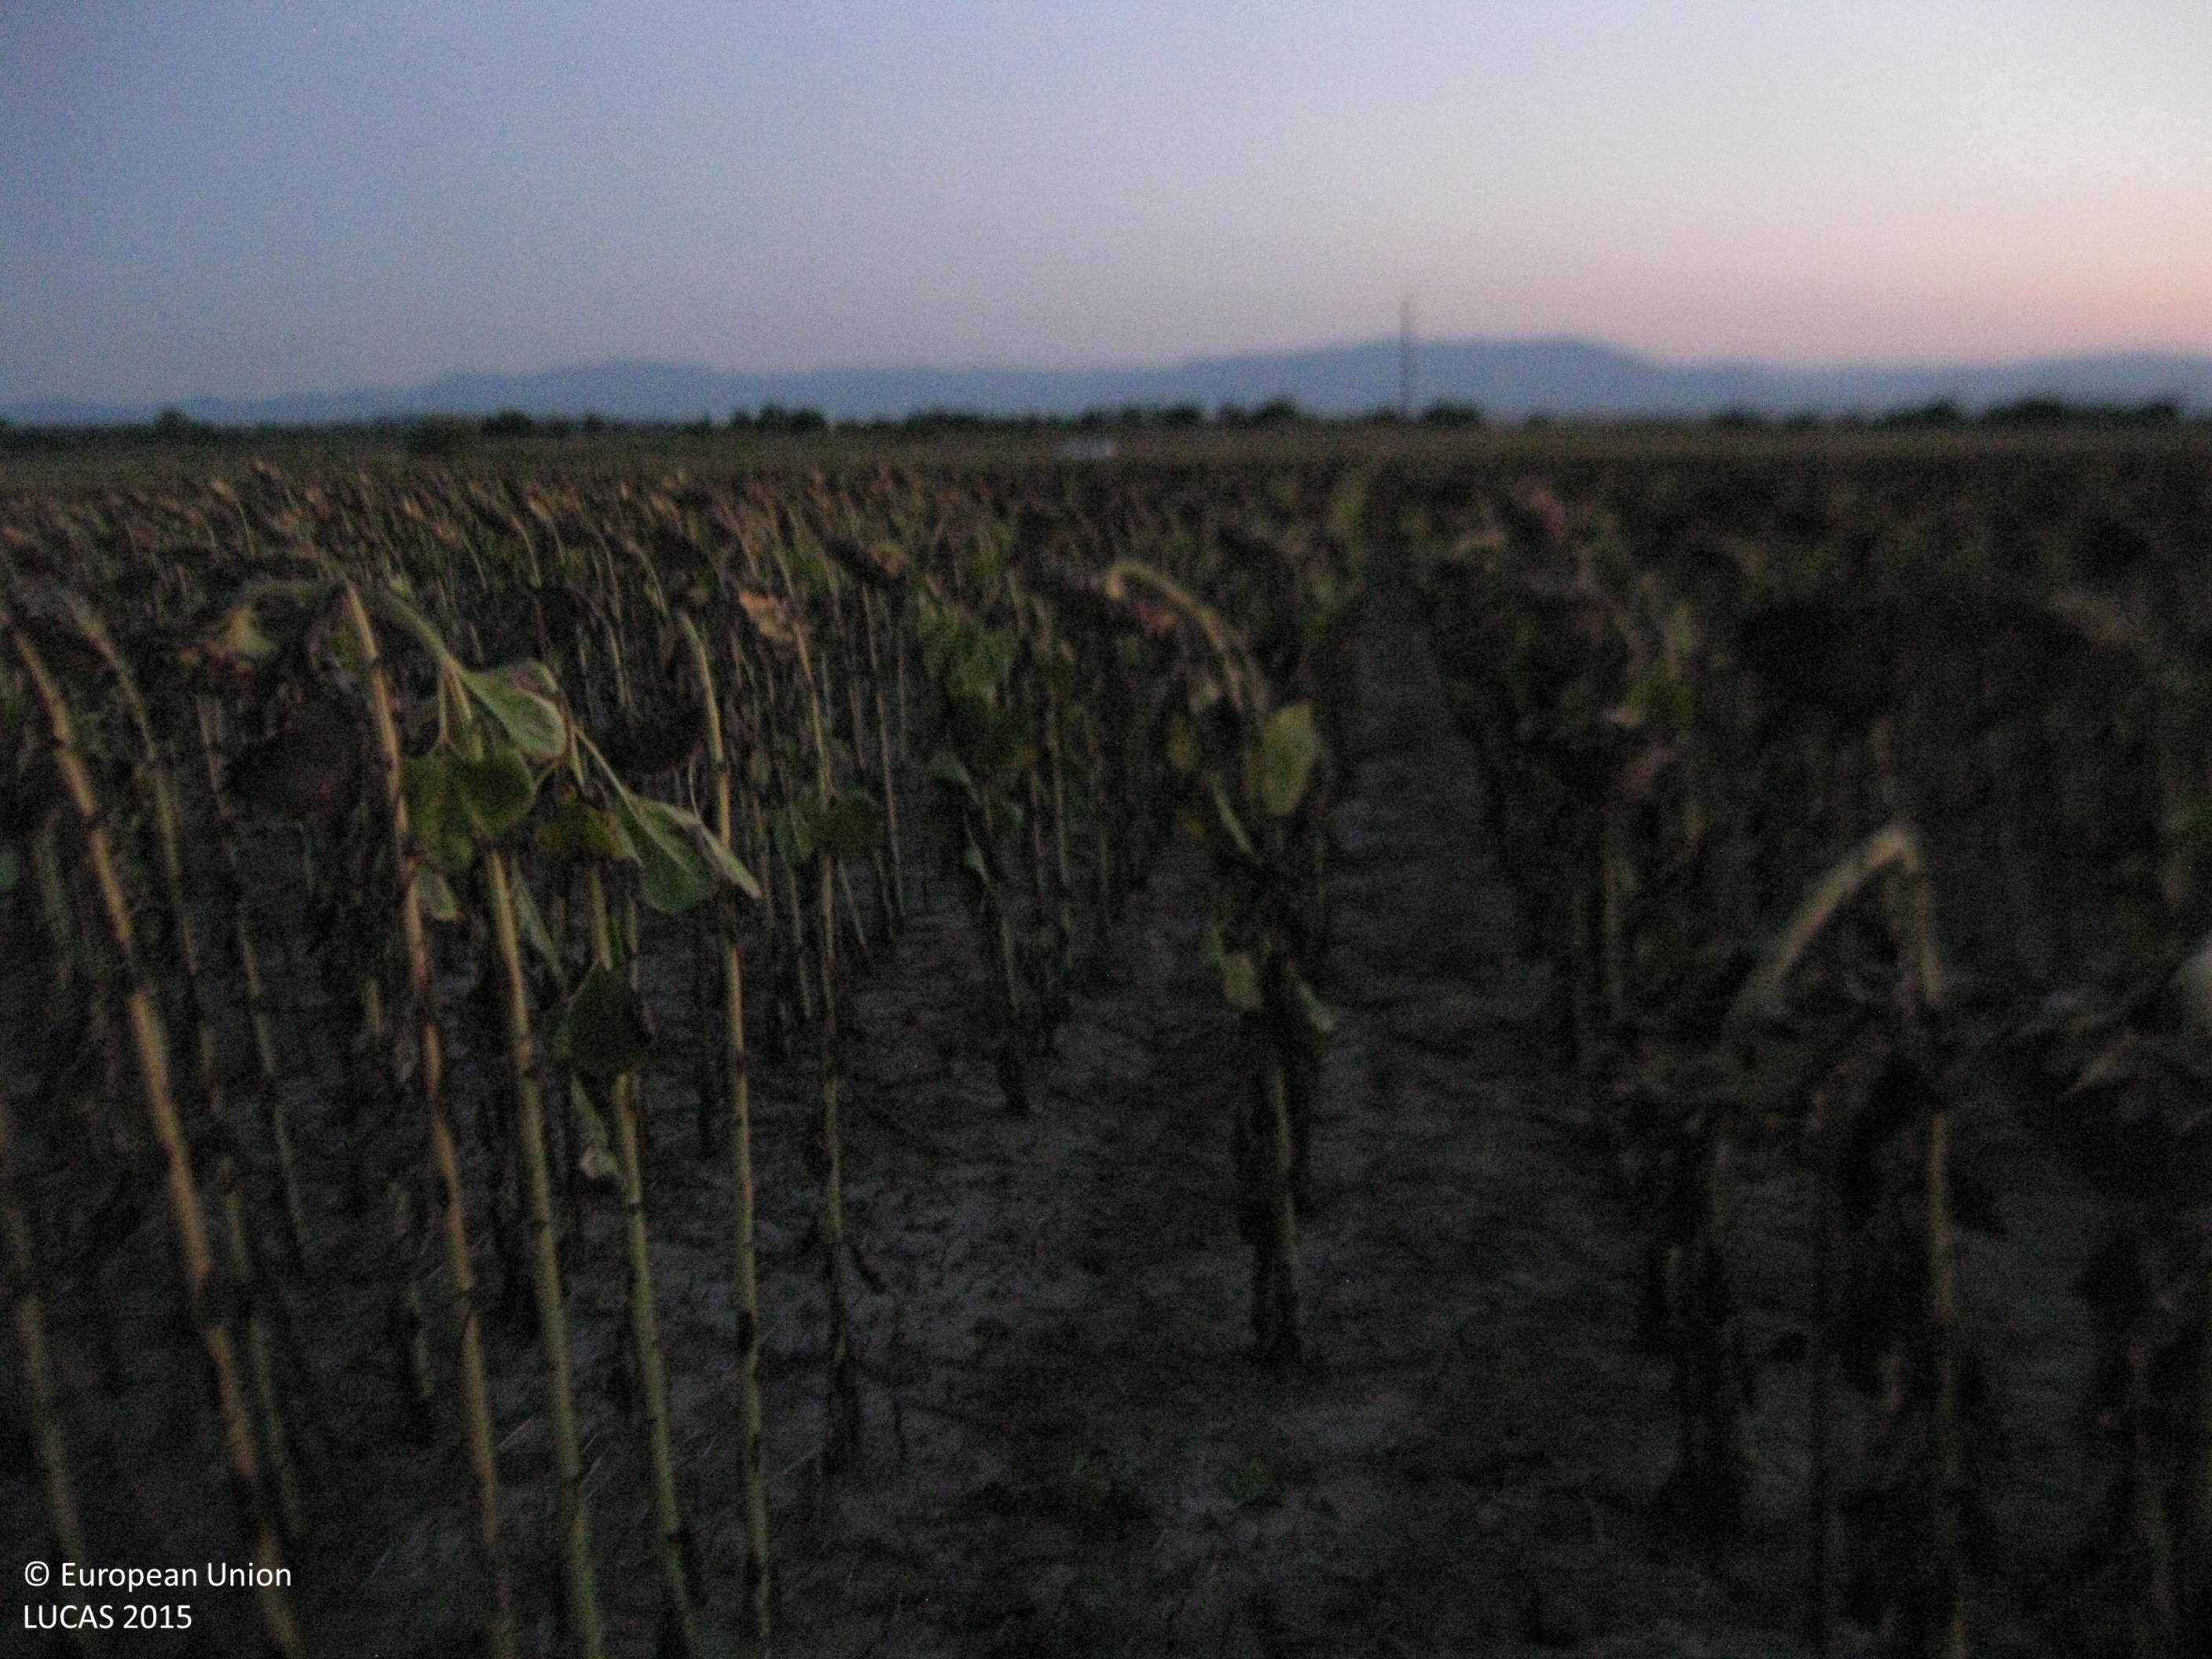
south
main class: Cropland
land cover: Sunflower
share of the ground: > 75 %
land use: Agriculture (excluding fallow land and kitchen gardens)
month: August
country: BG
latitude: 42.1810
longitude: 25.0584
